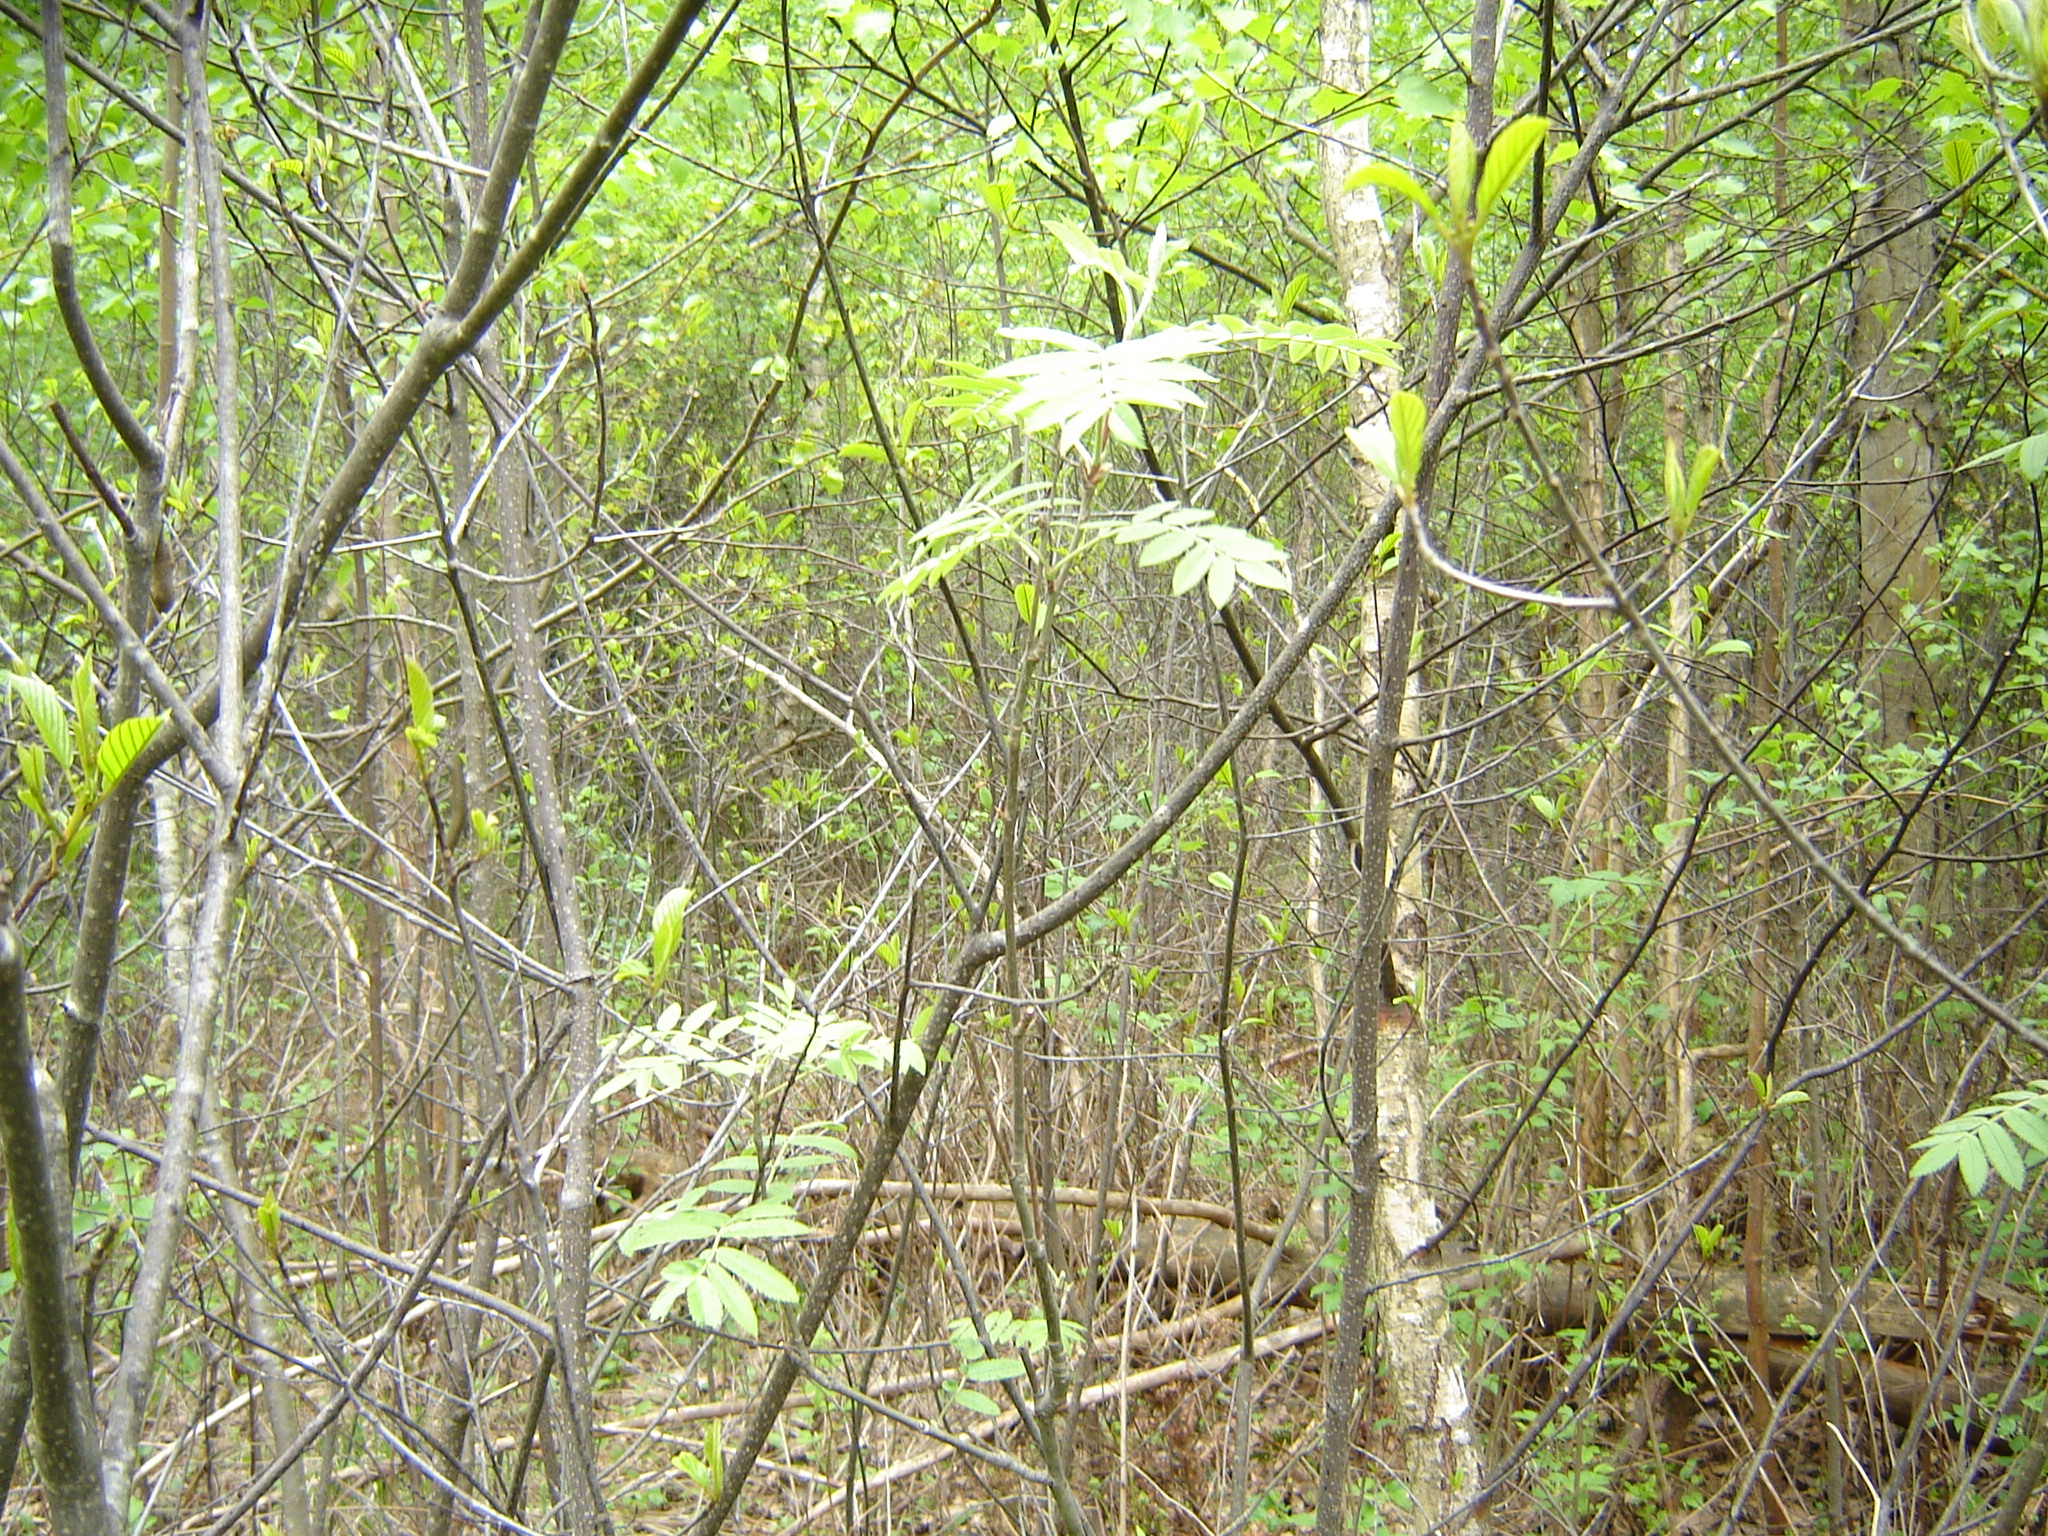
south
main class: Woodland
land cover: Other mixed woodland
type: hemiboreal forest and nemoral coniferous forest and mixed broadleaved-coniferous forest
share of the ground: > 75 %
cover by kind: coniferous forest trees 50 %, broadleaved forest trees 50 %
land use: Forestry
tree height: > 5 m
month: May
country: LT
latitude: 56.1221
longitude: 25.3181
